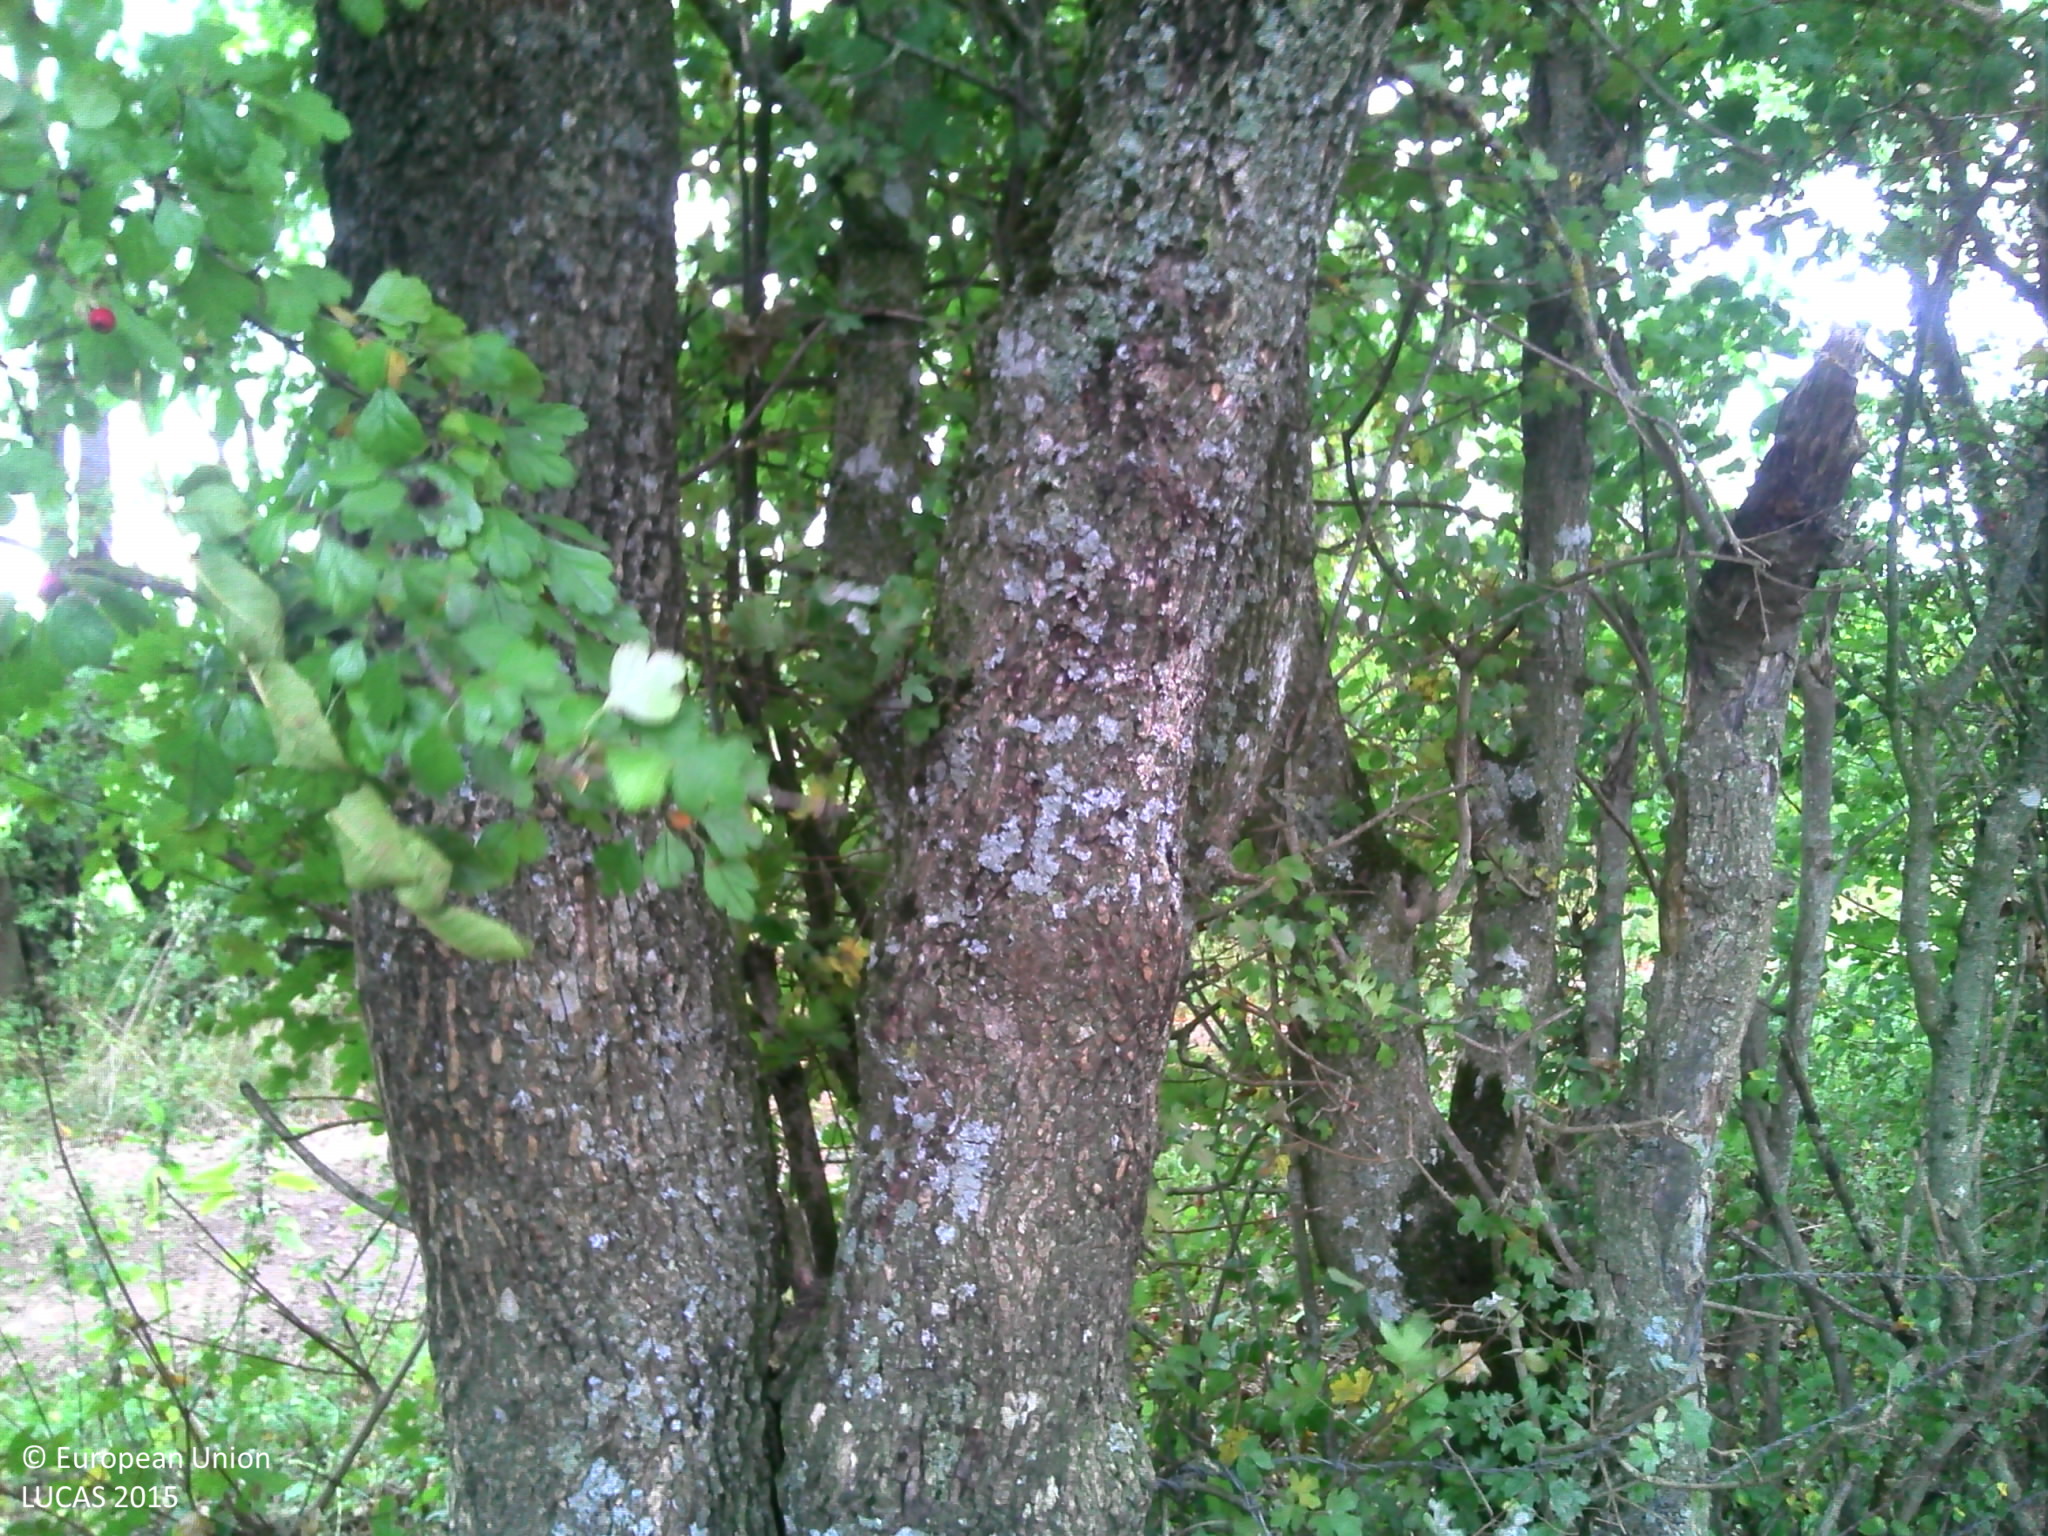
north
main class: Grassland
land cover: Grassland without tree/shrub cover
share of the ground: > 75 %
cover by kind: herbaceous plants 100 %
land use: Agriculture (excluding fallow land and kitchen gardens)
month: September
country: FR
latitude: 47.4520
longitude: 4.4418
